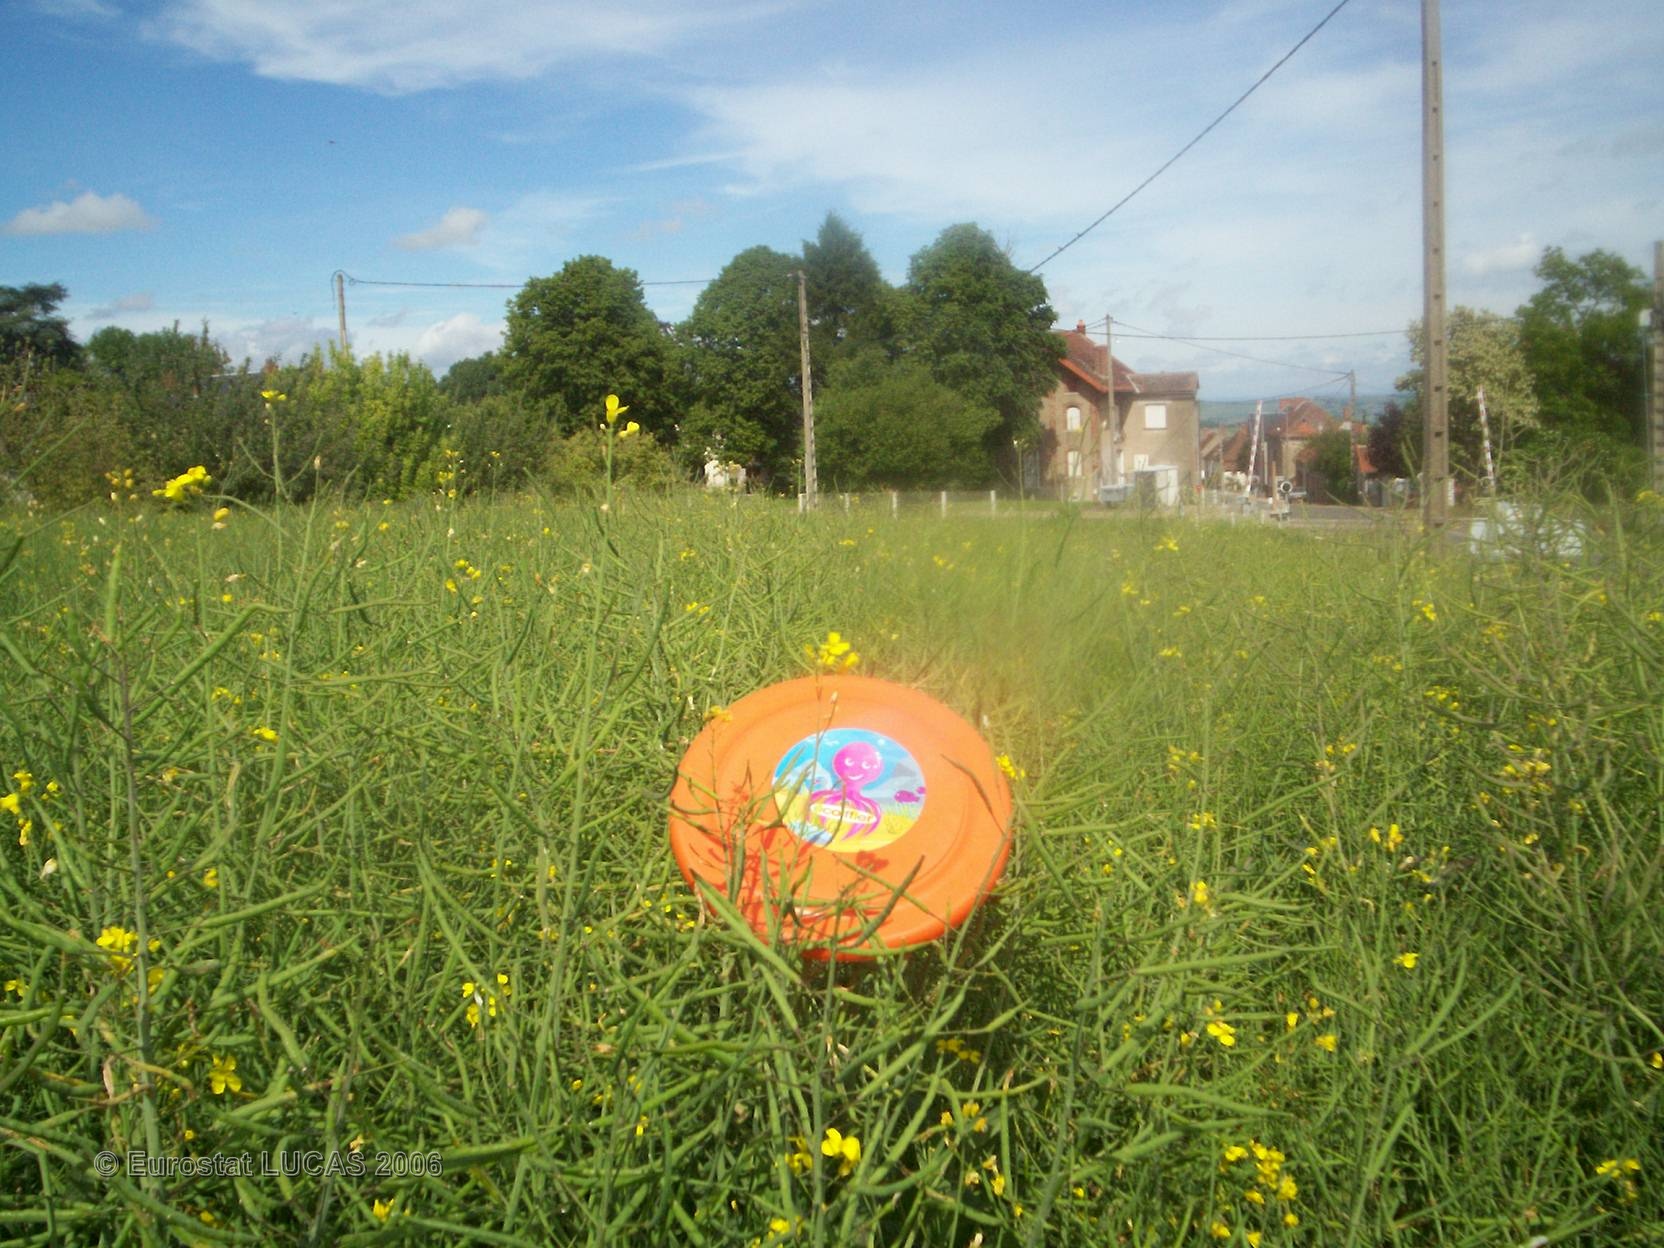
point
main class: Cropland
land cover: Rape and turnip rape
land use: Agriculture (excluding fallow land and kitchen gardens)
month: May
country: FR
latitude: 46.1983
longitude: 3.0653
